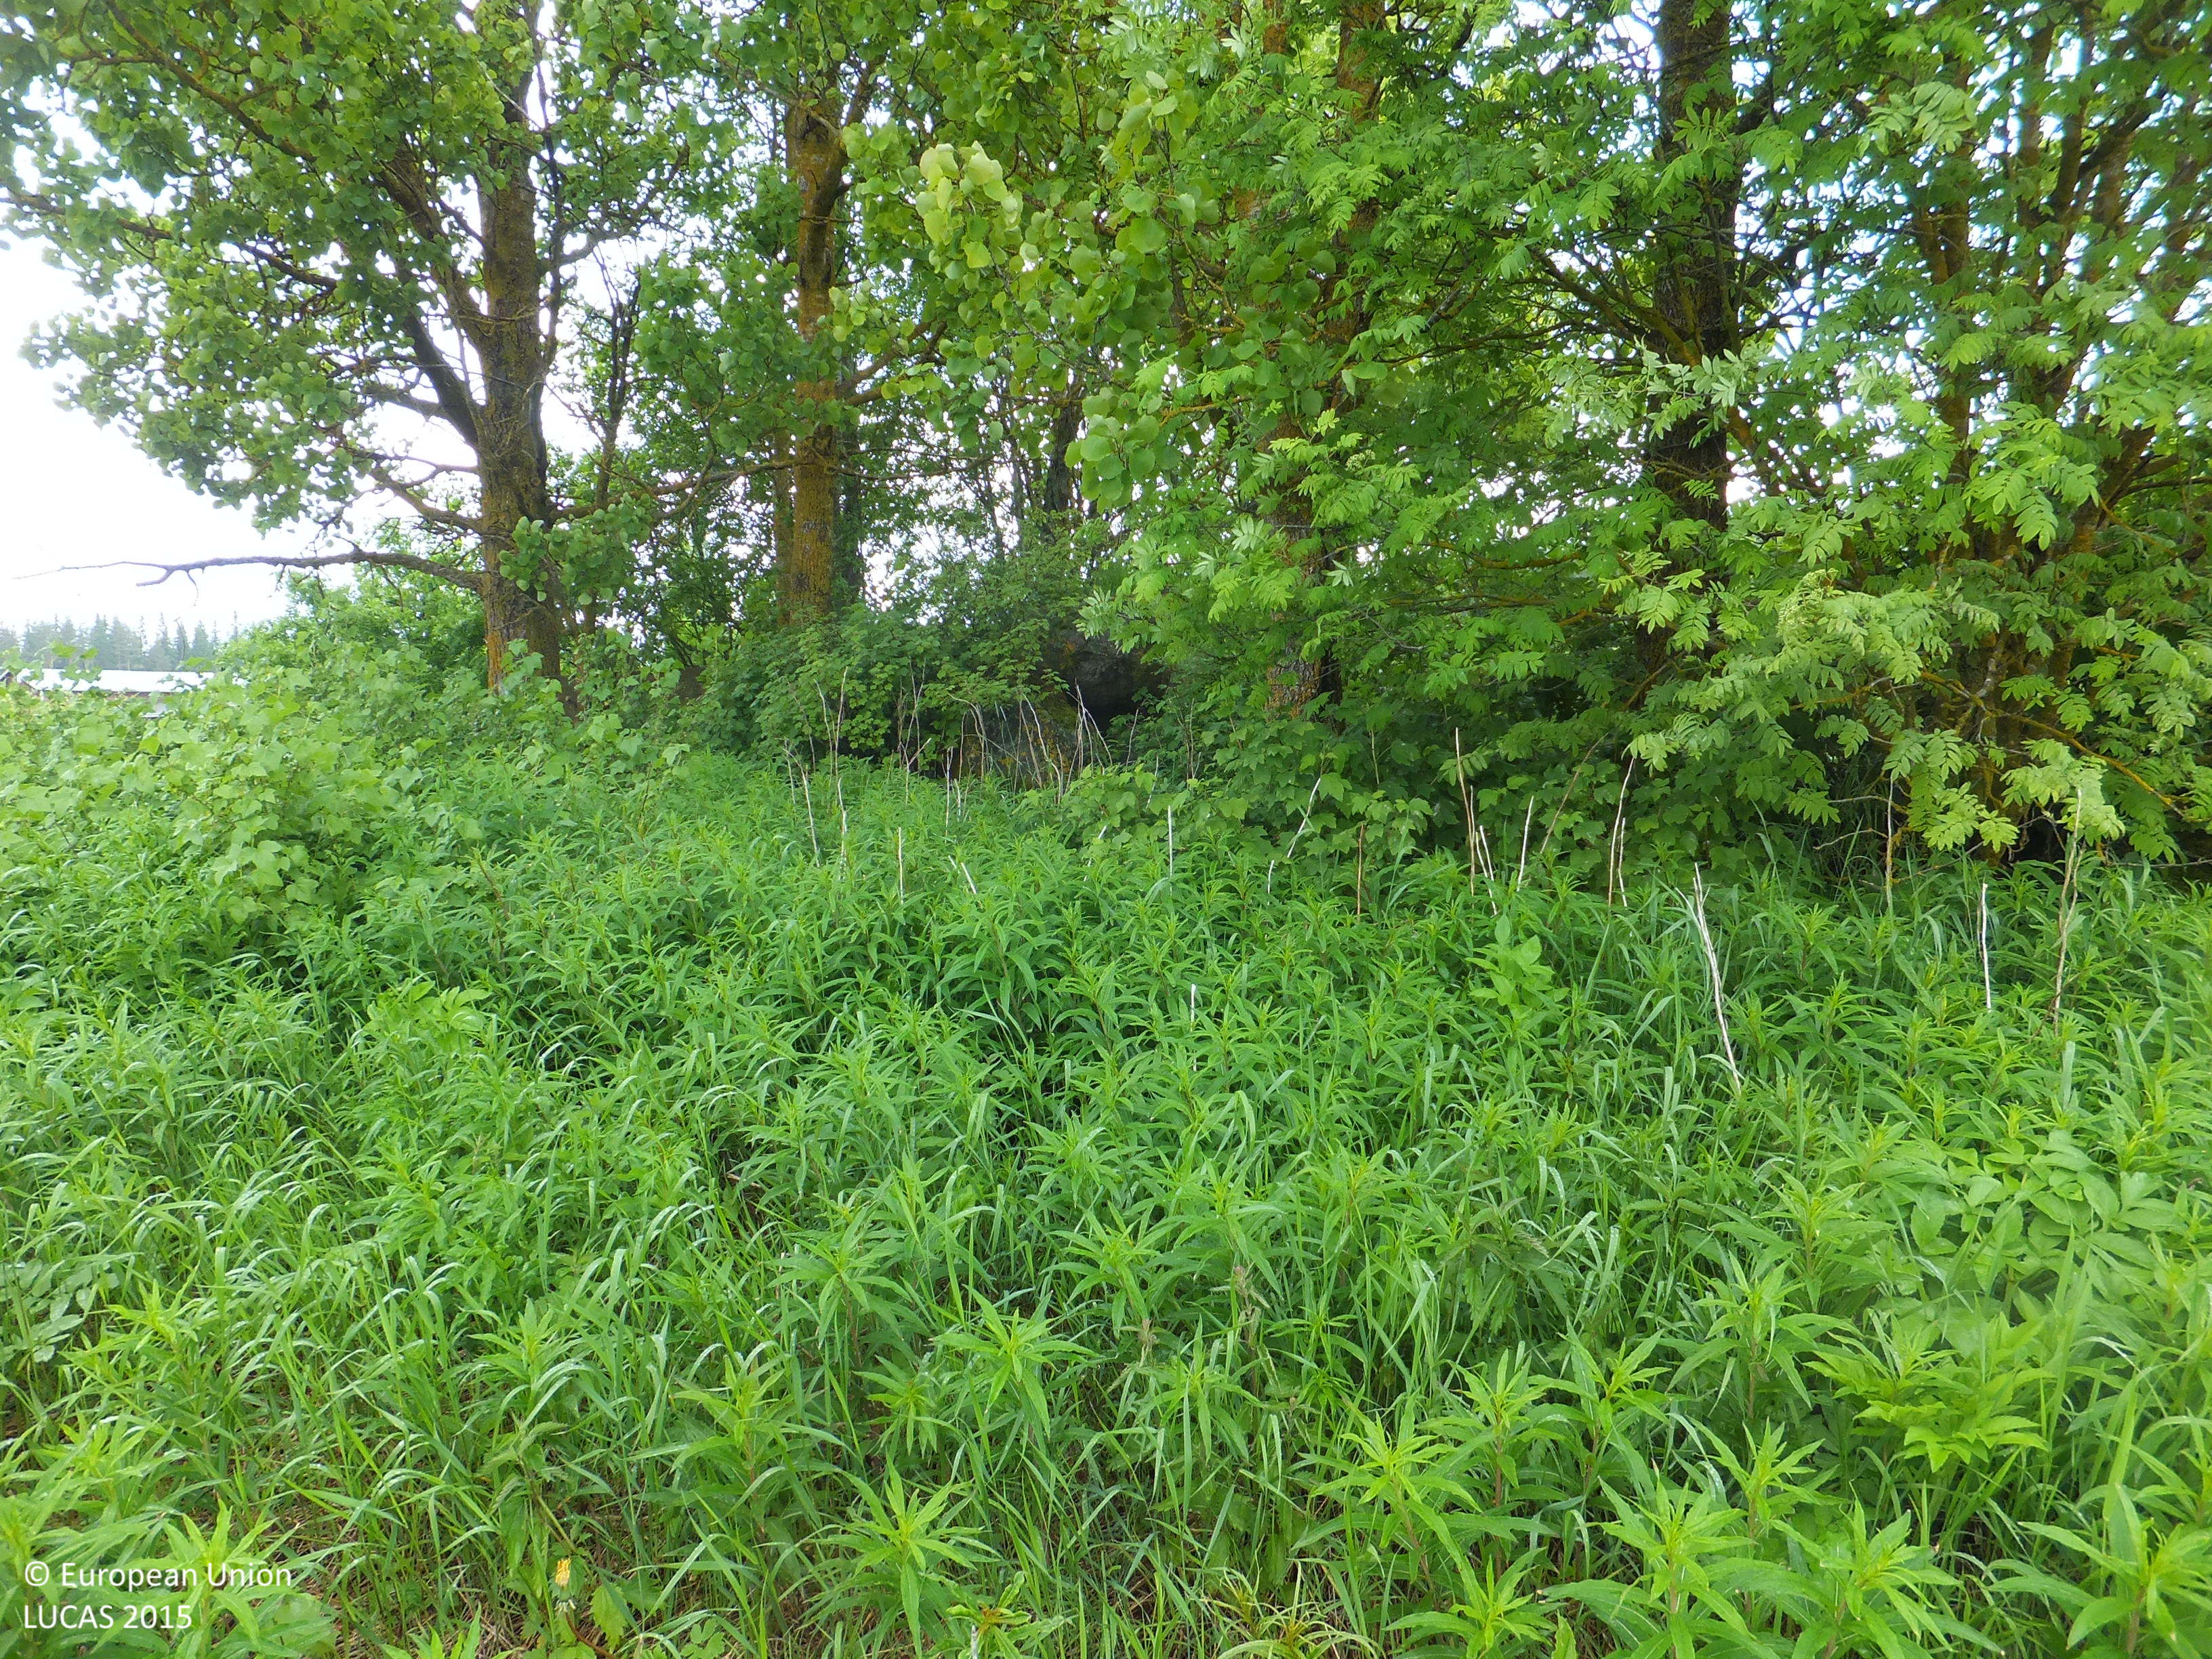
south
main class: Cropland
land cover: Barley
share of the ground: > 75 %
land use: Agriculture (excluding fallow land and kitchen gardens)
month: June
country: FI
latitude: 63.6165
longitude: 25.0769
